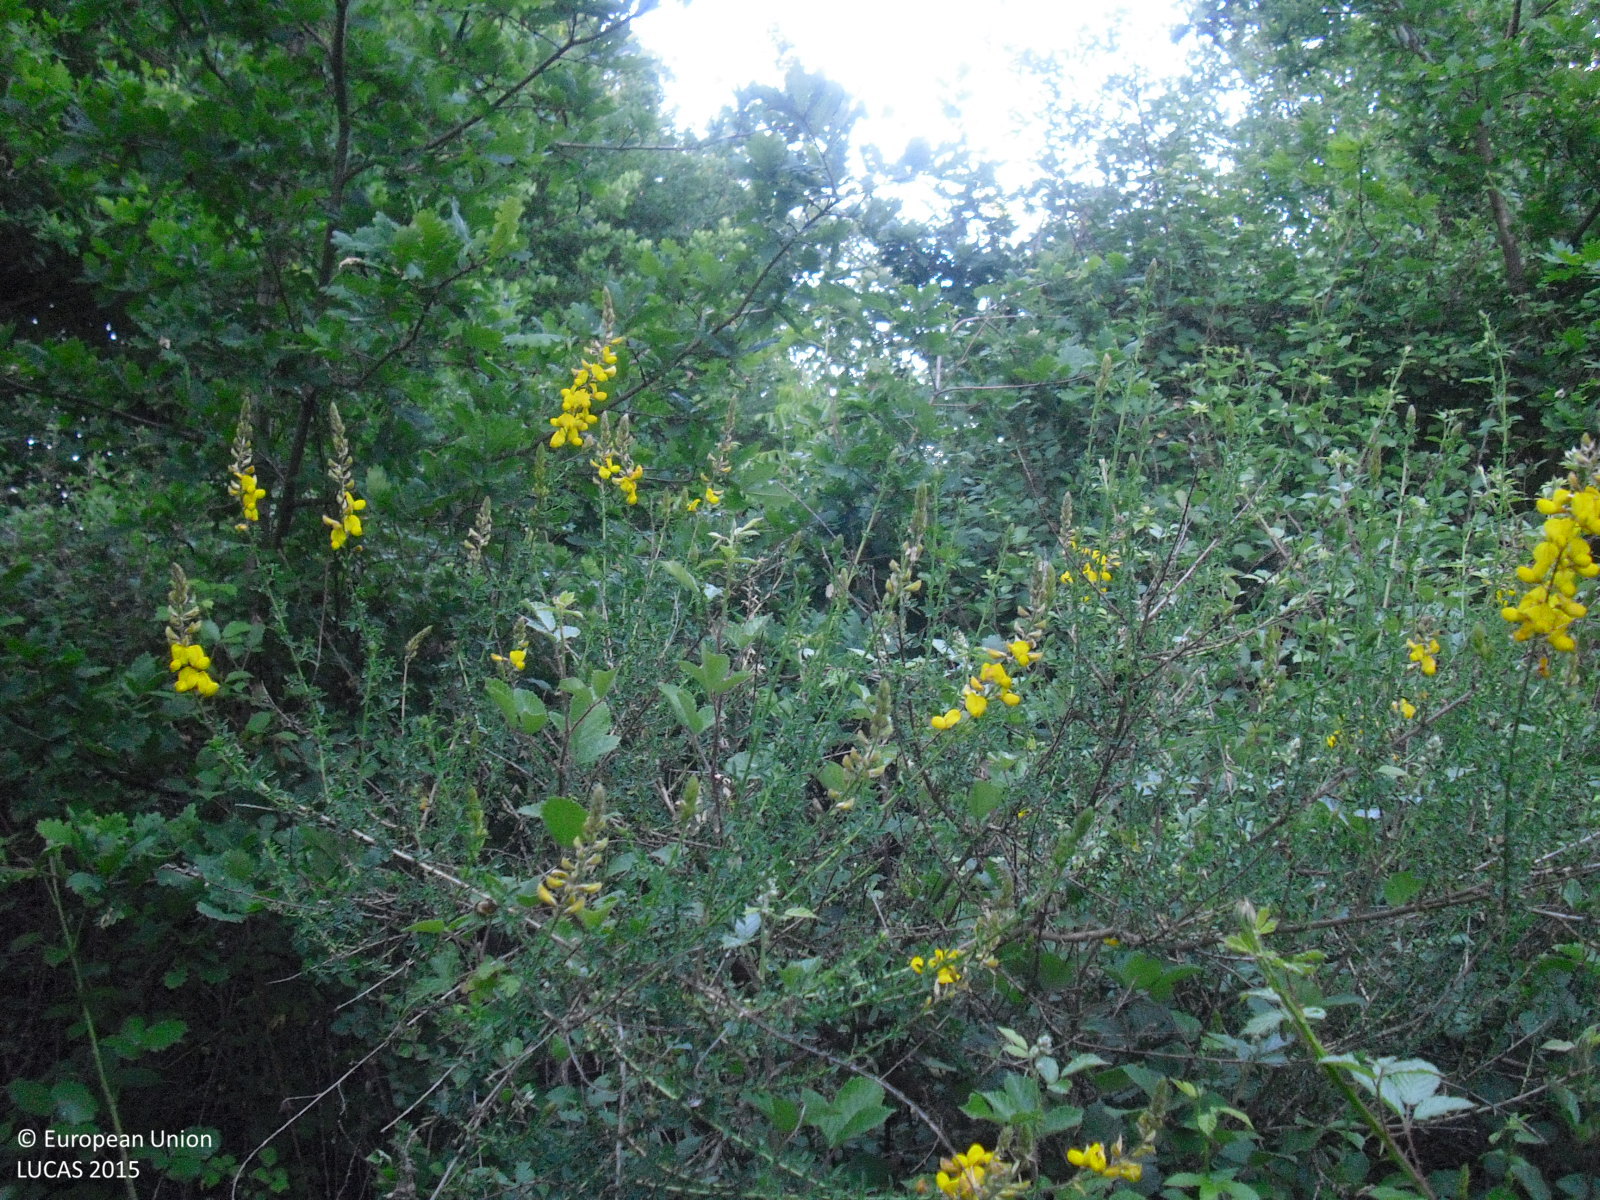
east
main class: Shrubland
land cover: Shrubland with sparse tree cover
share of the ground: > 75 %
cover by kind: shrubs 80 %, herbaceous plants 15 %, broadleaved forest trees 5 %
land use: Abandoned areas
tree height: < 5 m
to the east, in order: Shrubland with sparse tree cover; Broadleaved woodland; Dry stone walls; Broadleaved woodland; Grassland with sparse tree/shrub cover; Abandoned hedges; Grassland without tree/shrub cover; Shruby margins; Dry stone walls; Broadleaved woodland
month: May
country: ES
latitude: 42.2290
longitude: -7.7751
